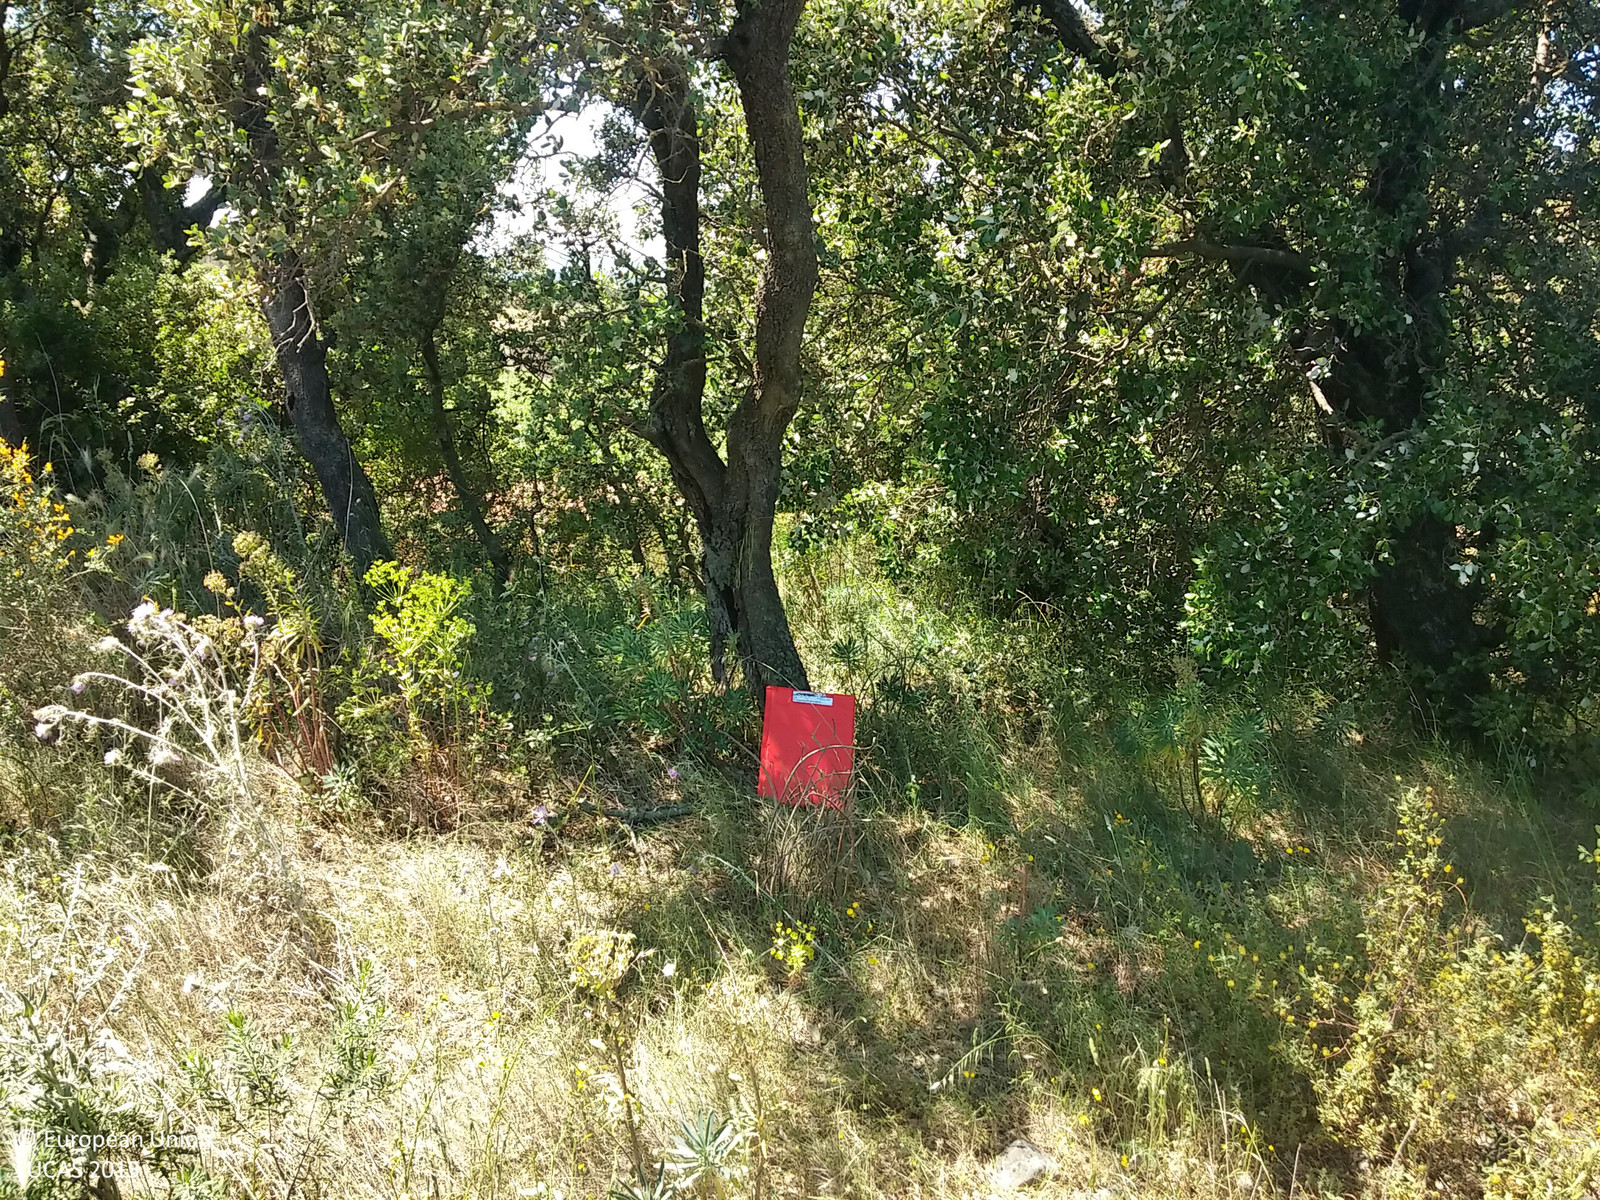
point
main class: Woodland
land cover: Broadleaved woodland
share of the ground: 25 - 50 %
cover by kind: herbaceous plants 55 %, broadleaved forest trees 35 %, shrubs 10 %
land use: Forestry
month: May
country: ES
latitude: 42.3545
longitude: 2.9602
